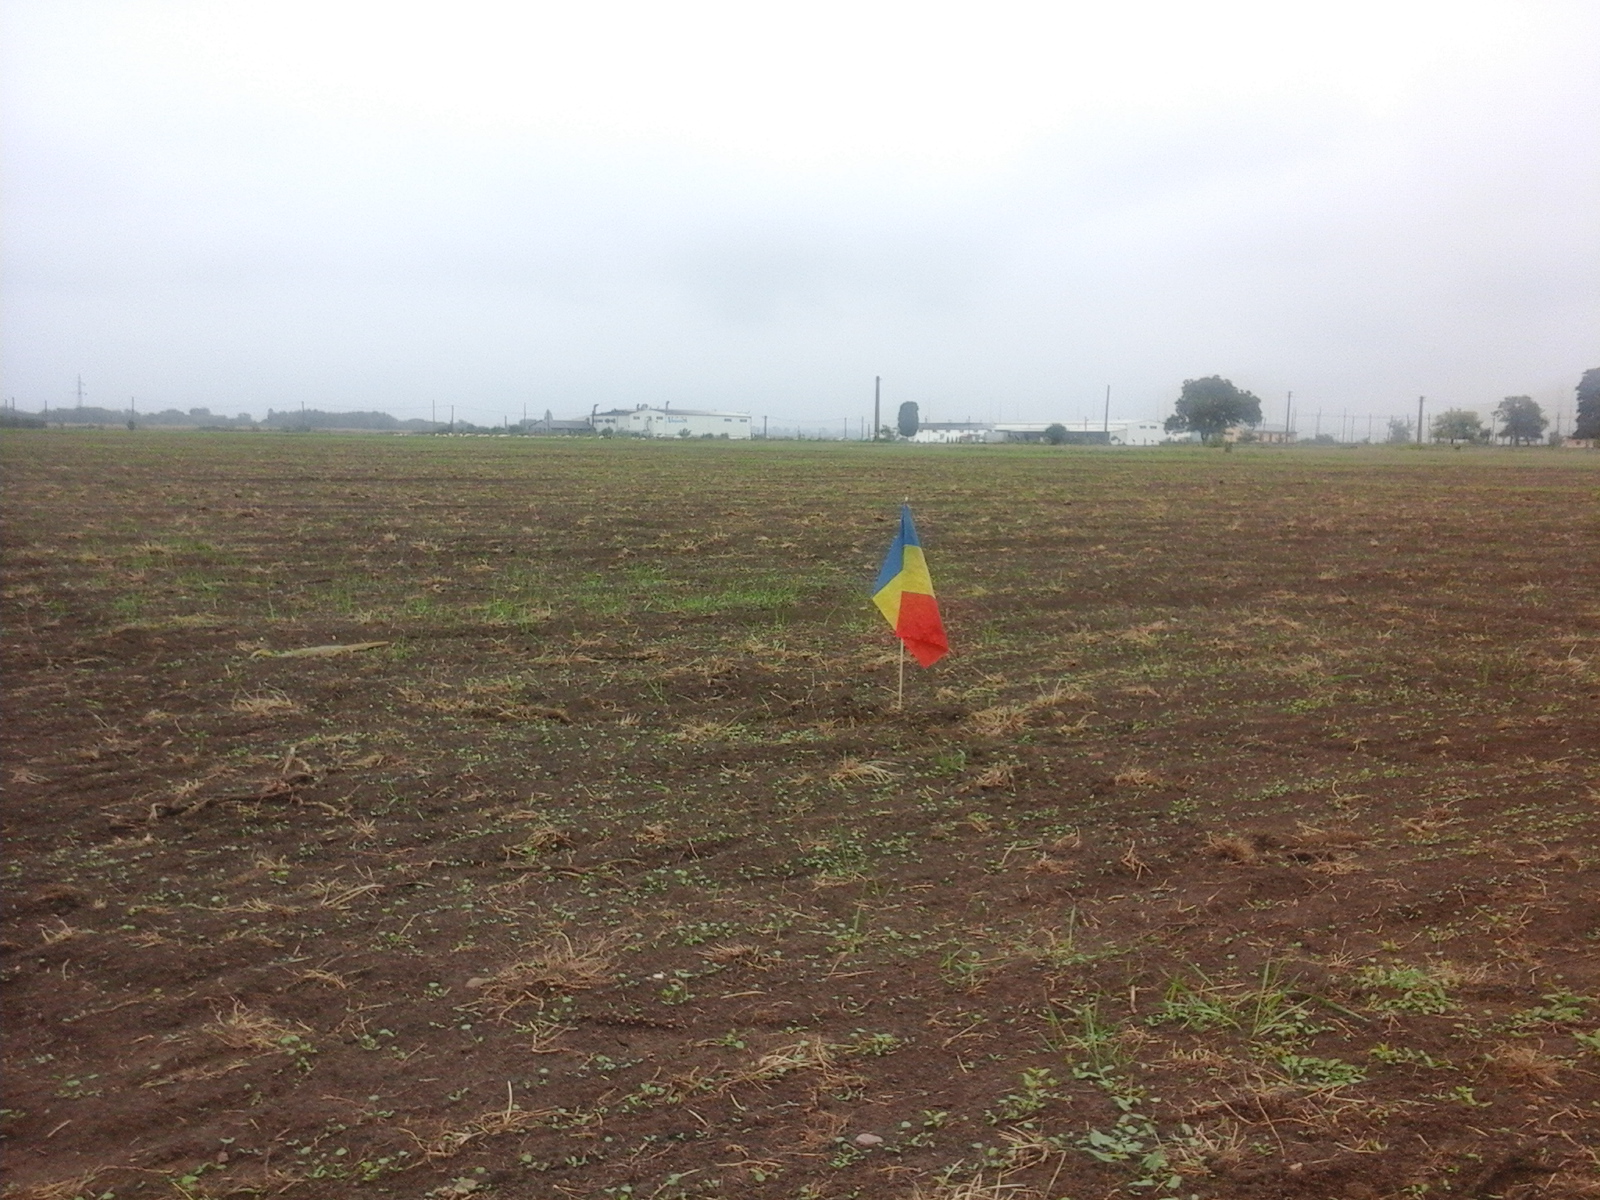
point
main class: Cropland
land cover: Dry pulses
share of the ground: < 10 %
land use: Agriculture (excluding fallow land and kitchen gardens)
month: September
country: RO
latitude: 47.0746
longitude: 21.8317
